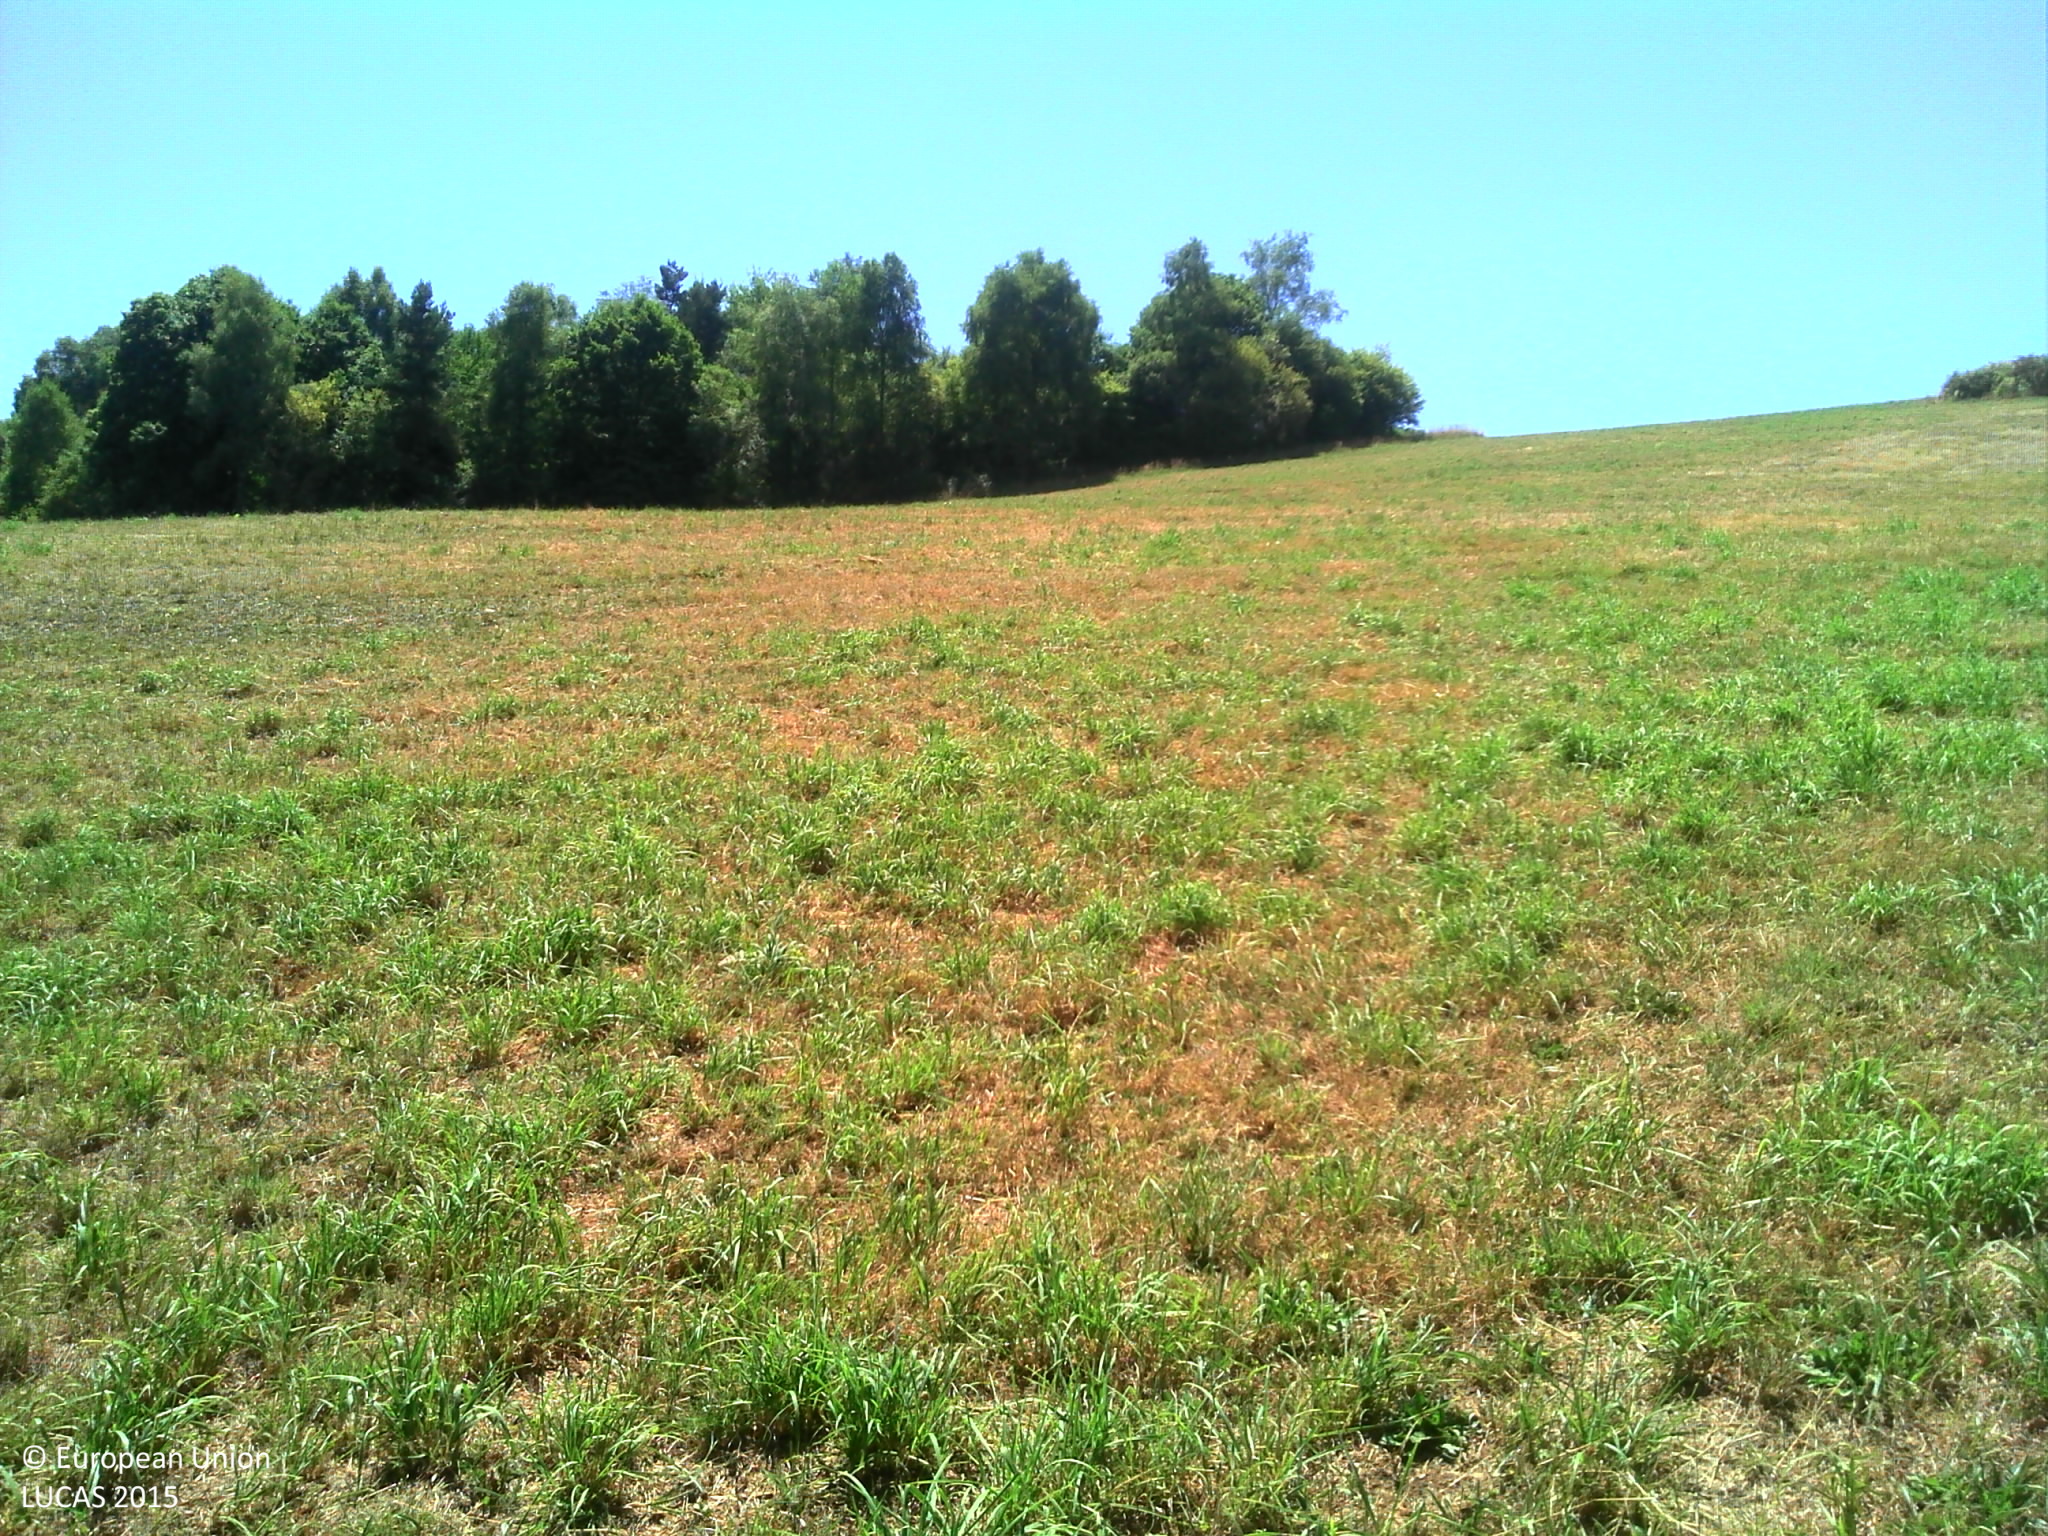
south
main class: Grassland
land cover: Grassland without tree/shrub cover
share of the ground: > 75 %
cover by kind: herbaceous plants 95 %
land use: Agriculture (excluding fallow land and kitchen gardens)
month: July
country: FR
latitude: 45.6255
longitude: 1.6441
